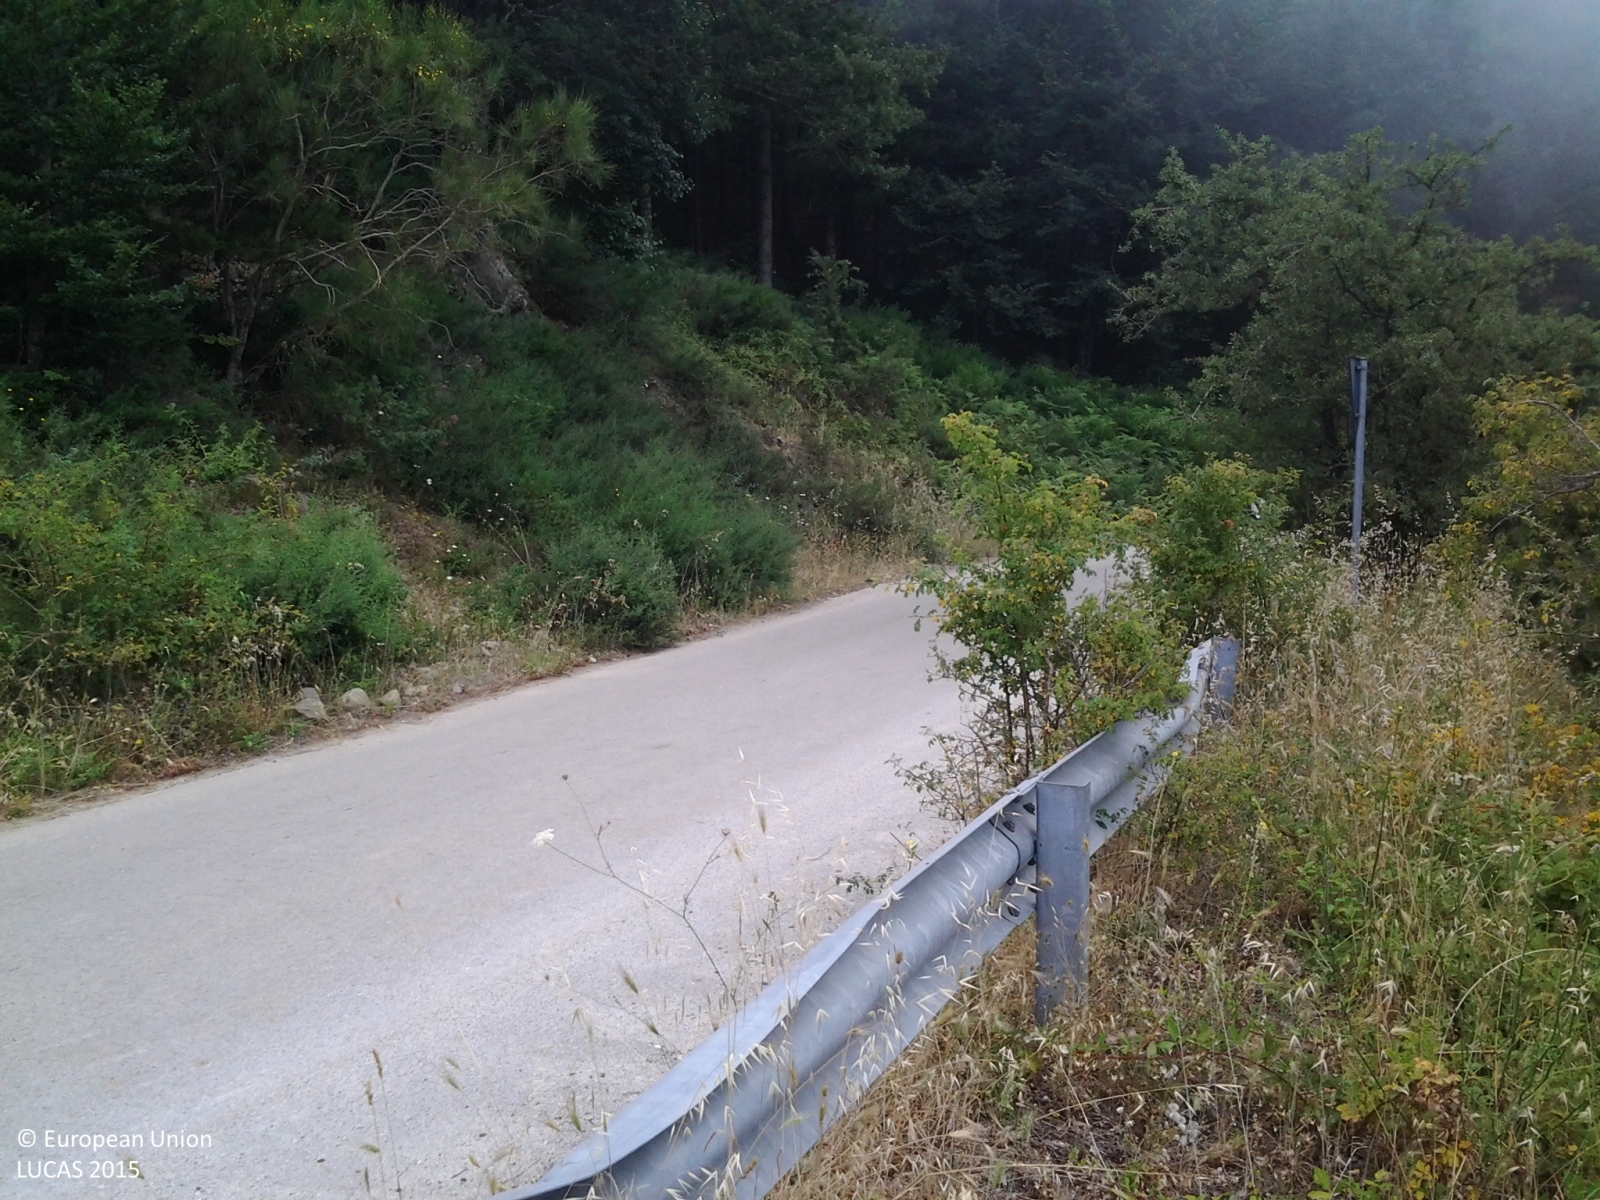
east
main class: Woodland
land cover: Broadleaved woodland
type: thermophilous deciduous forest
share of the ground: > 75 %
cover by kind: broadleaved forest trees 90 %, shrubs 5 %, herbaceous plants 5 %
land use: Amenities, museums, leisure
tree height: > 5 m
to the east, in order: Broadleaved woodland
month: July
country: IT
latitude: 37.9861
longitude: 14.8745
